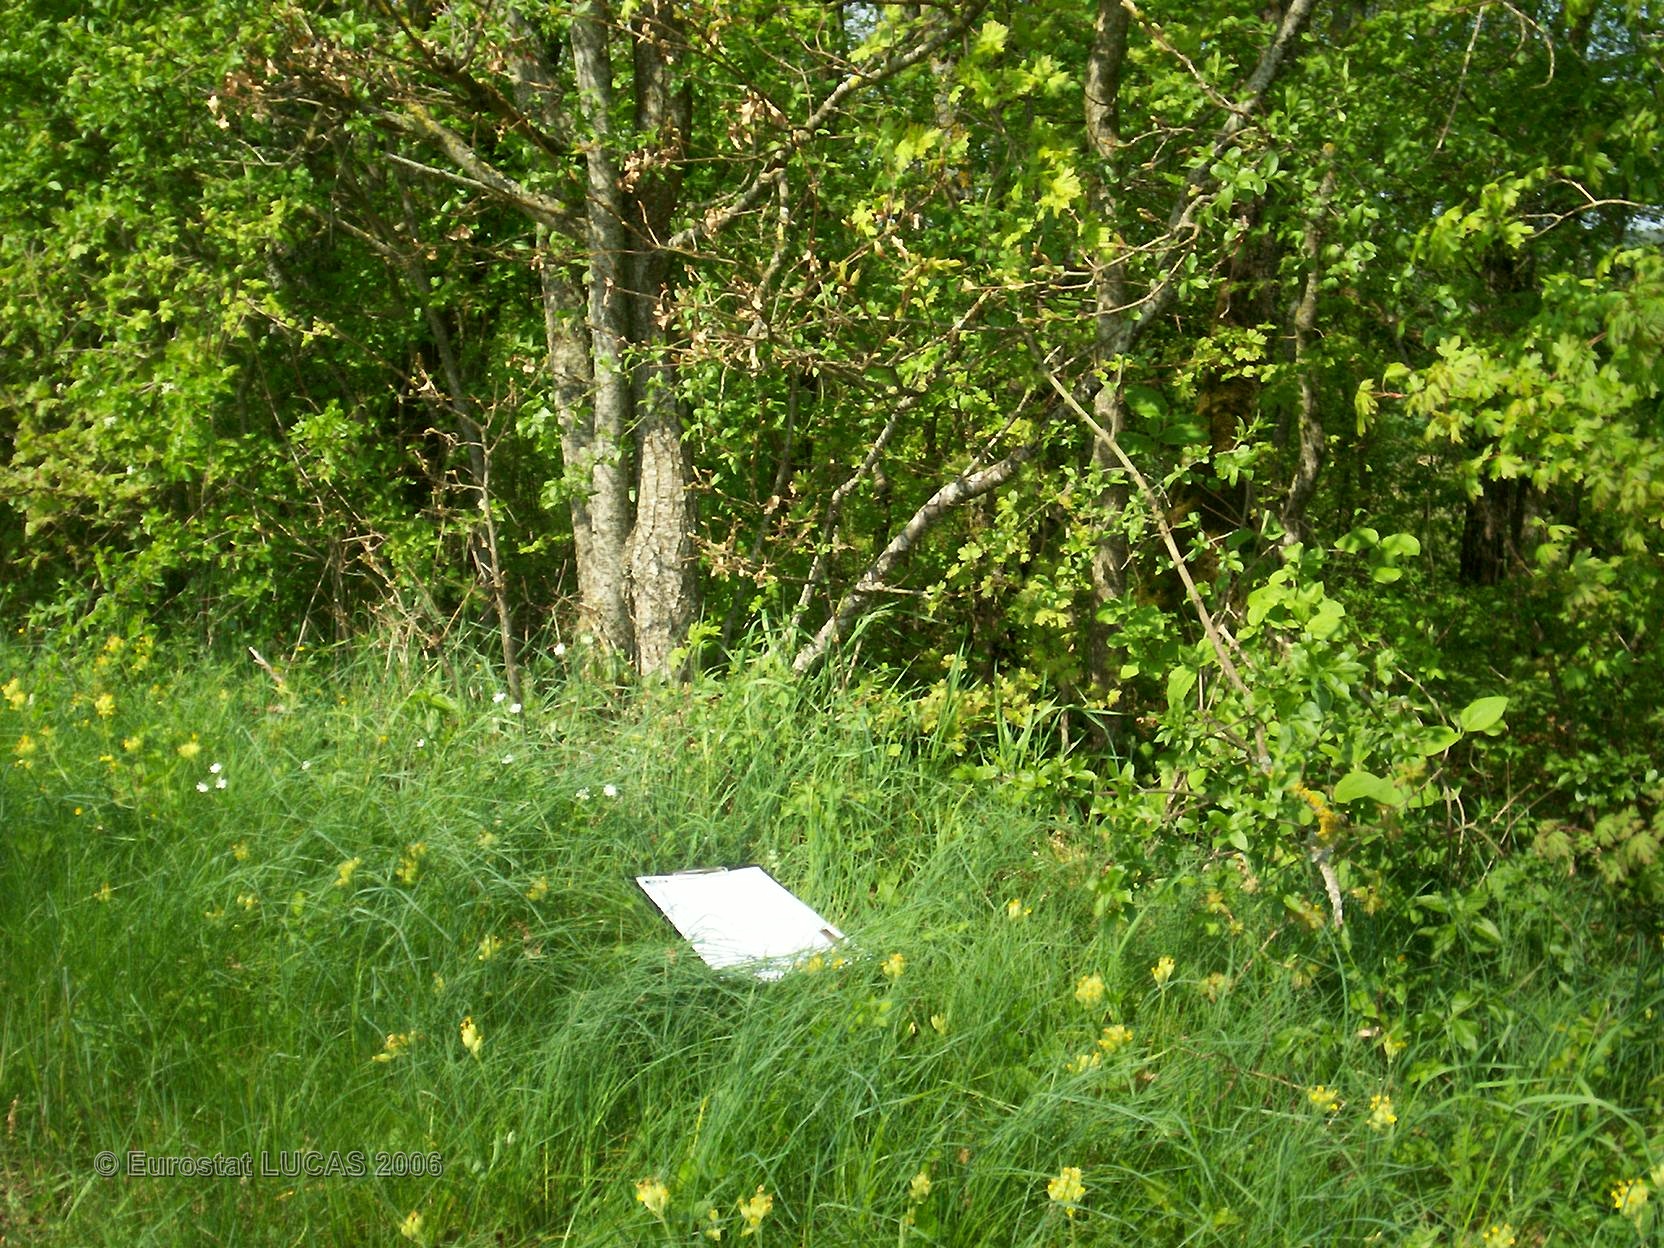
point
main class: Cropland
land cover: Barley
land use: Agriculture (excluding fallow land and kitchen gardens)
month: May
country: FR
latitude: 47.5125
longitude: 4.5684
